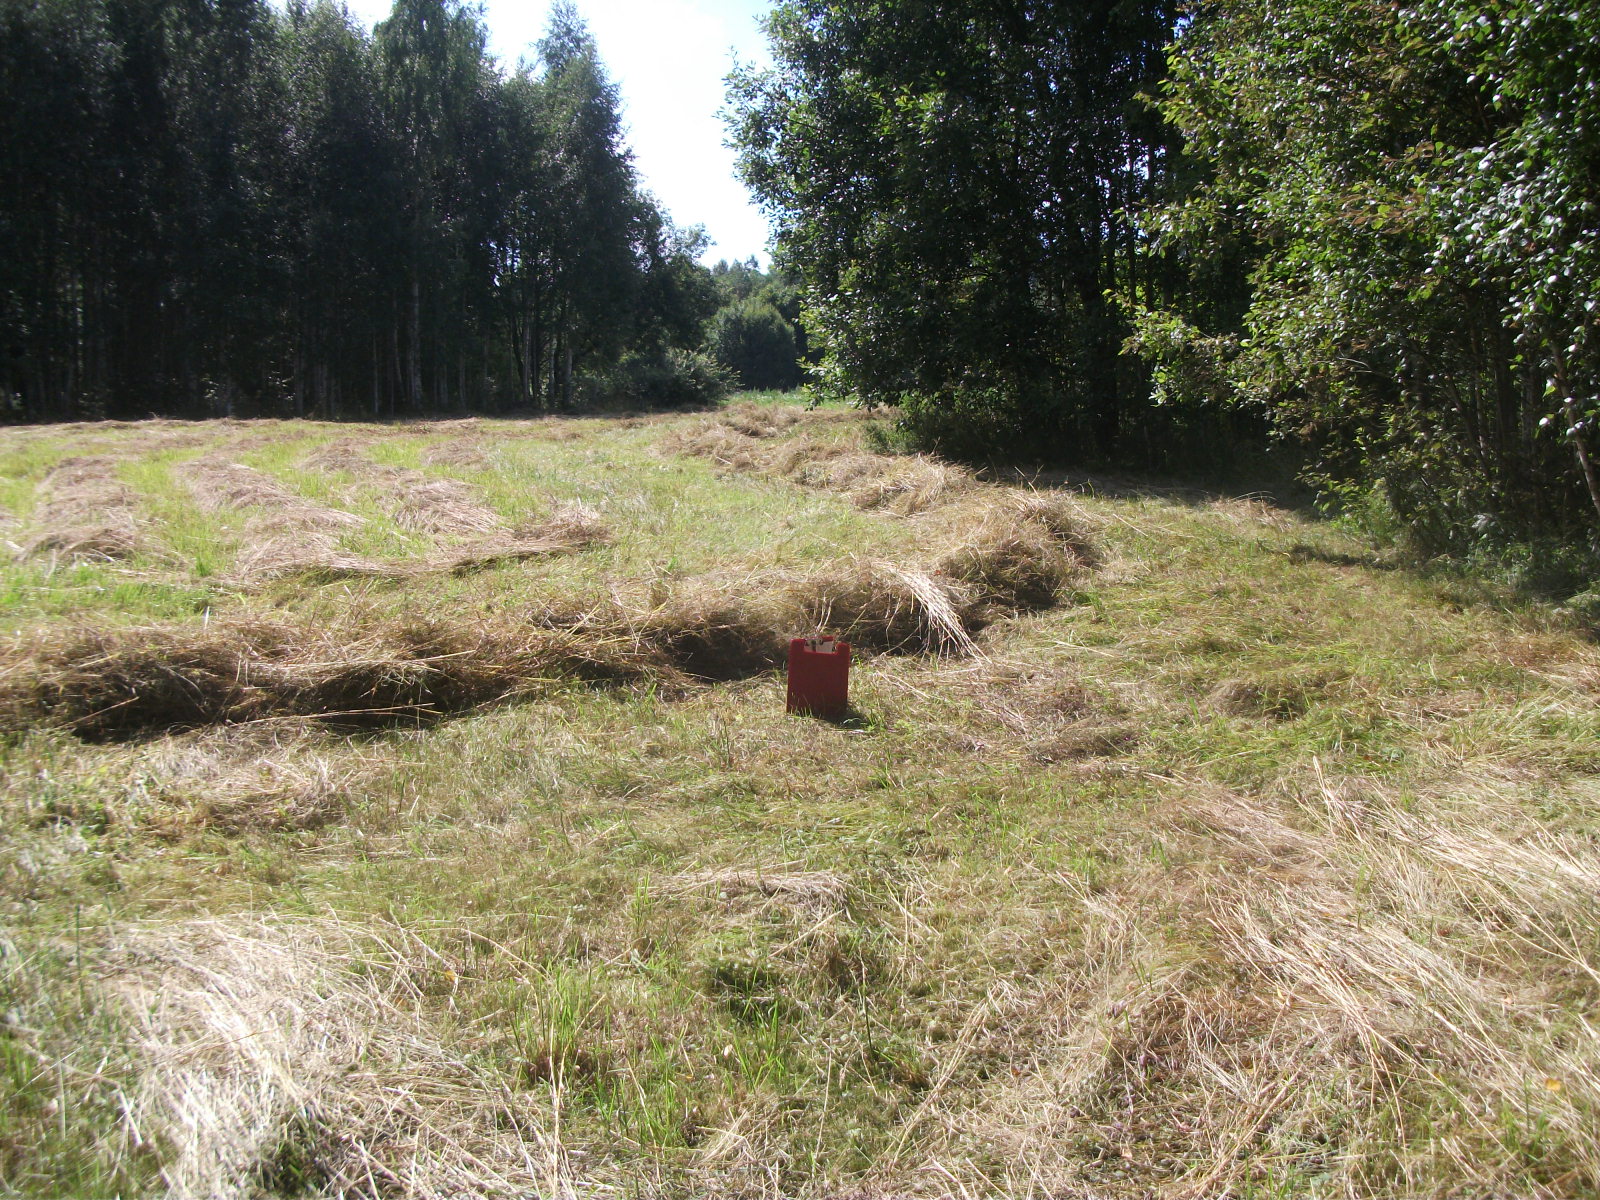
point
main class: Grassland
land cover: Grassland without tree/shrub cover
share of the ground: > 75 %
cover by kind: herbaceous plants 100 %
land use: Agriculture (excluding fallow land and kitchen gardens)
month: August
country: LV
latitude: 57.0930
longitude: 26.6703
